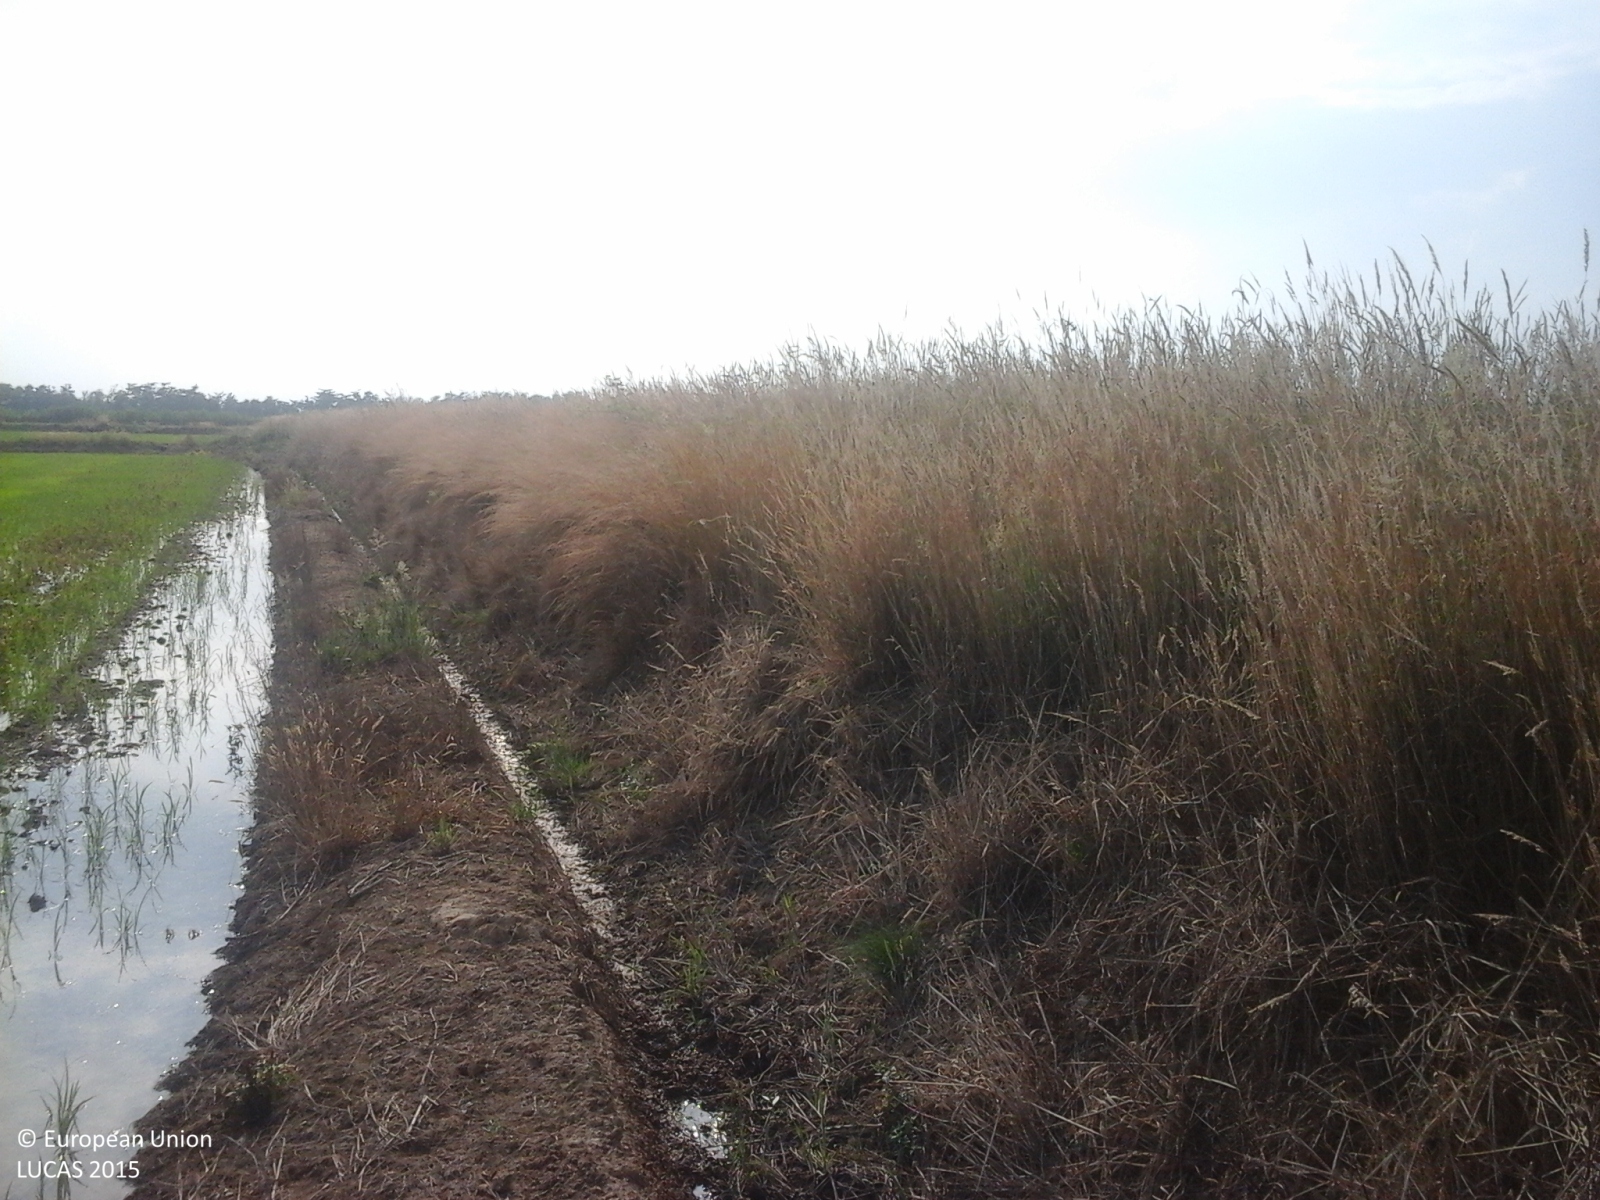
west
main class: Cropland
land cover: Rice
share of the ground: 50 - 75 %
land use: Agriculture (excluding fallow land and kitchen gardens)
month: June
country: IT
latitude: 45.4907
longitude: 8.3010
